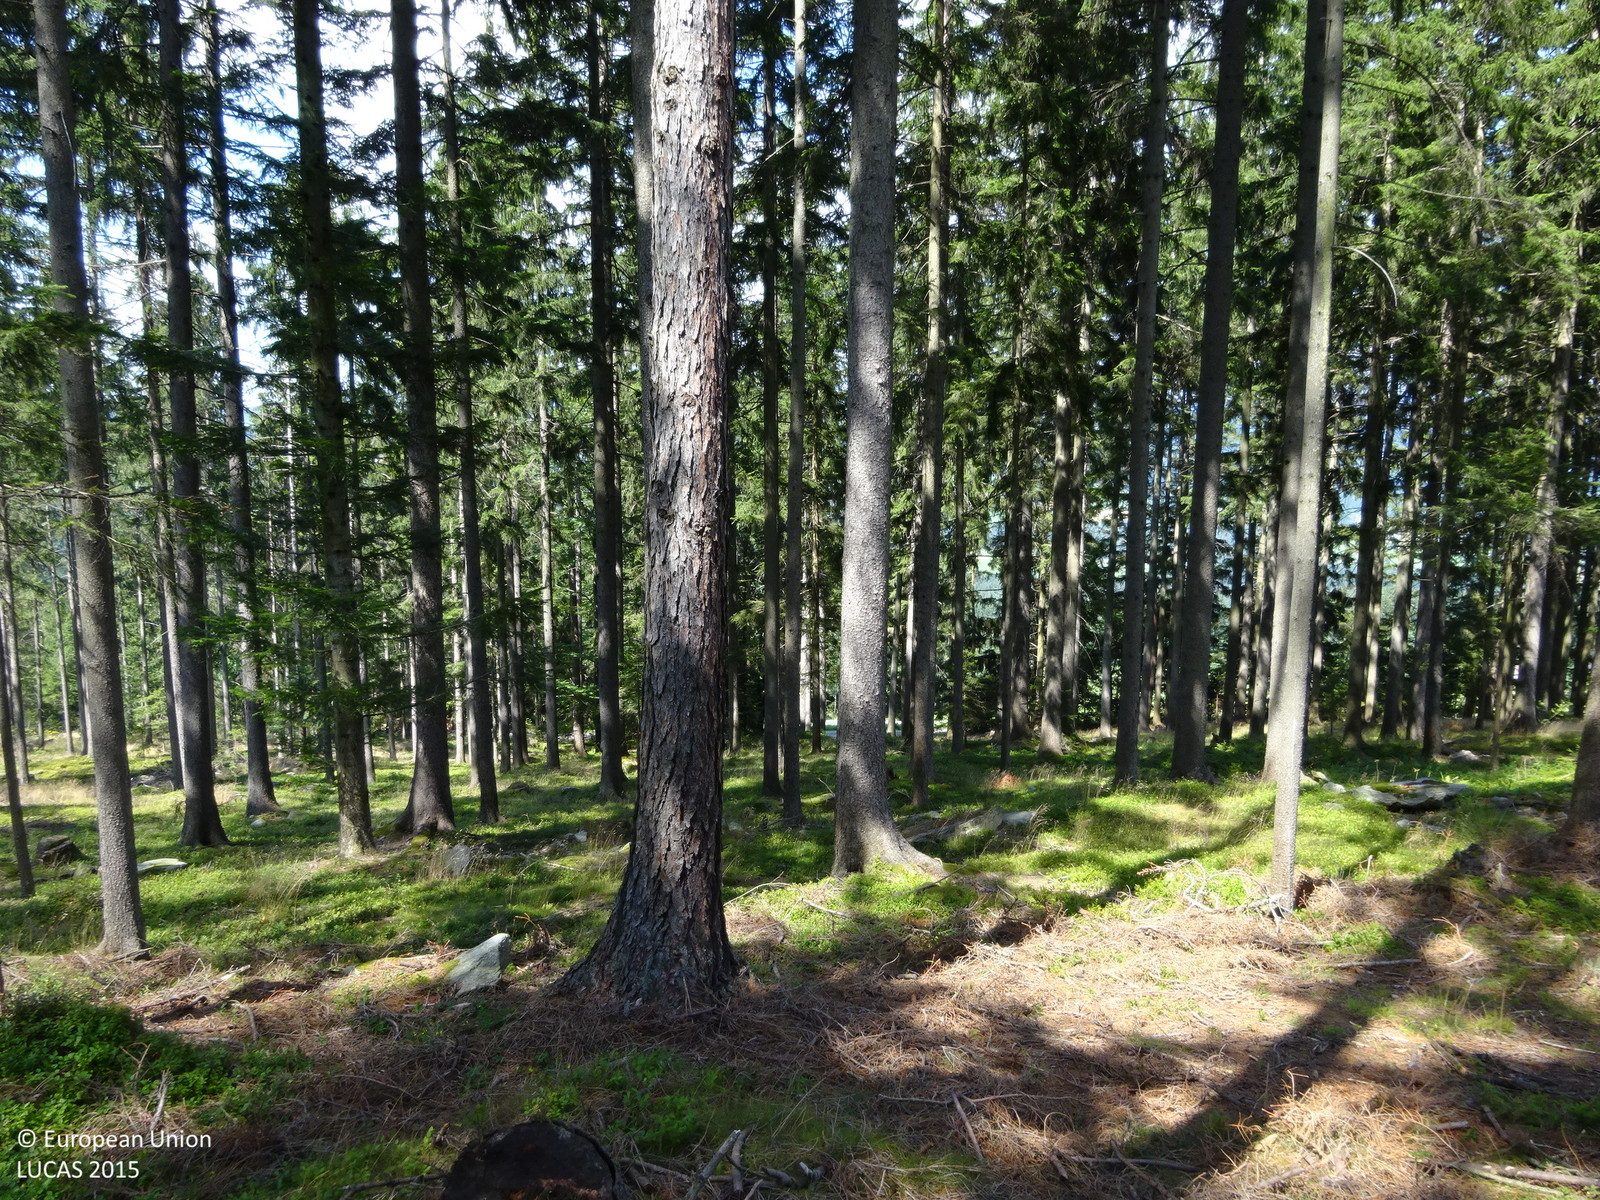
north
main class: Woodland
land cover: Spruce dominated coniferous woodland
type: alpine coniferous forest
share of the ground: > 75 %
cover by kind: coniferous forest trees 95 %, herbaceous plants 5 %
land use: Forestry
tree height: > 5 m
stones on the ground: < 10 %
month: August
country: AT
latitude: 47.3154
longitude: 15.7558
